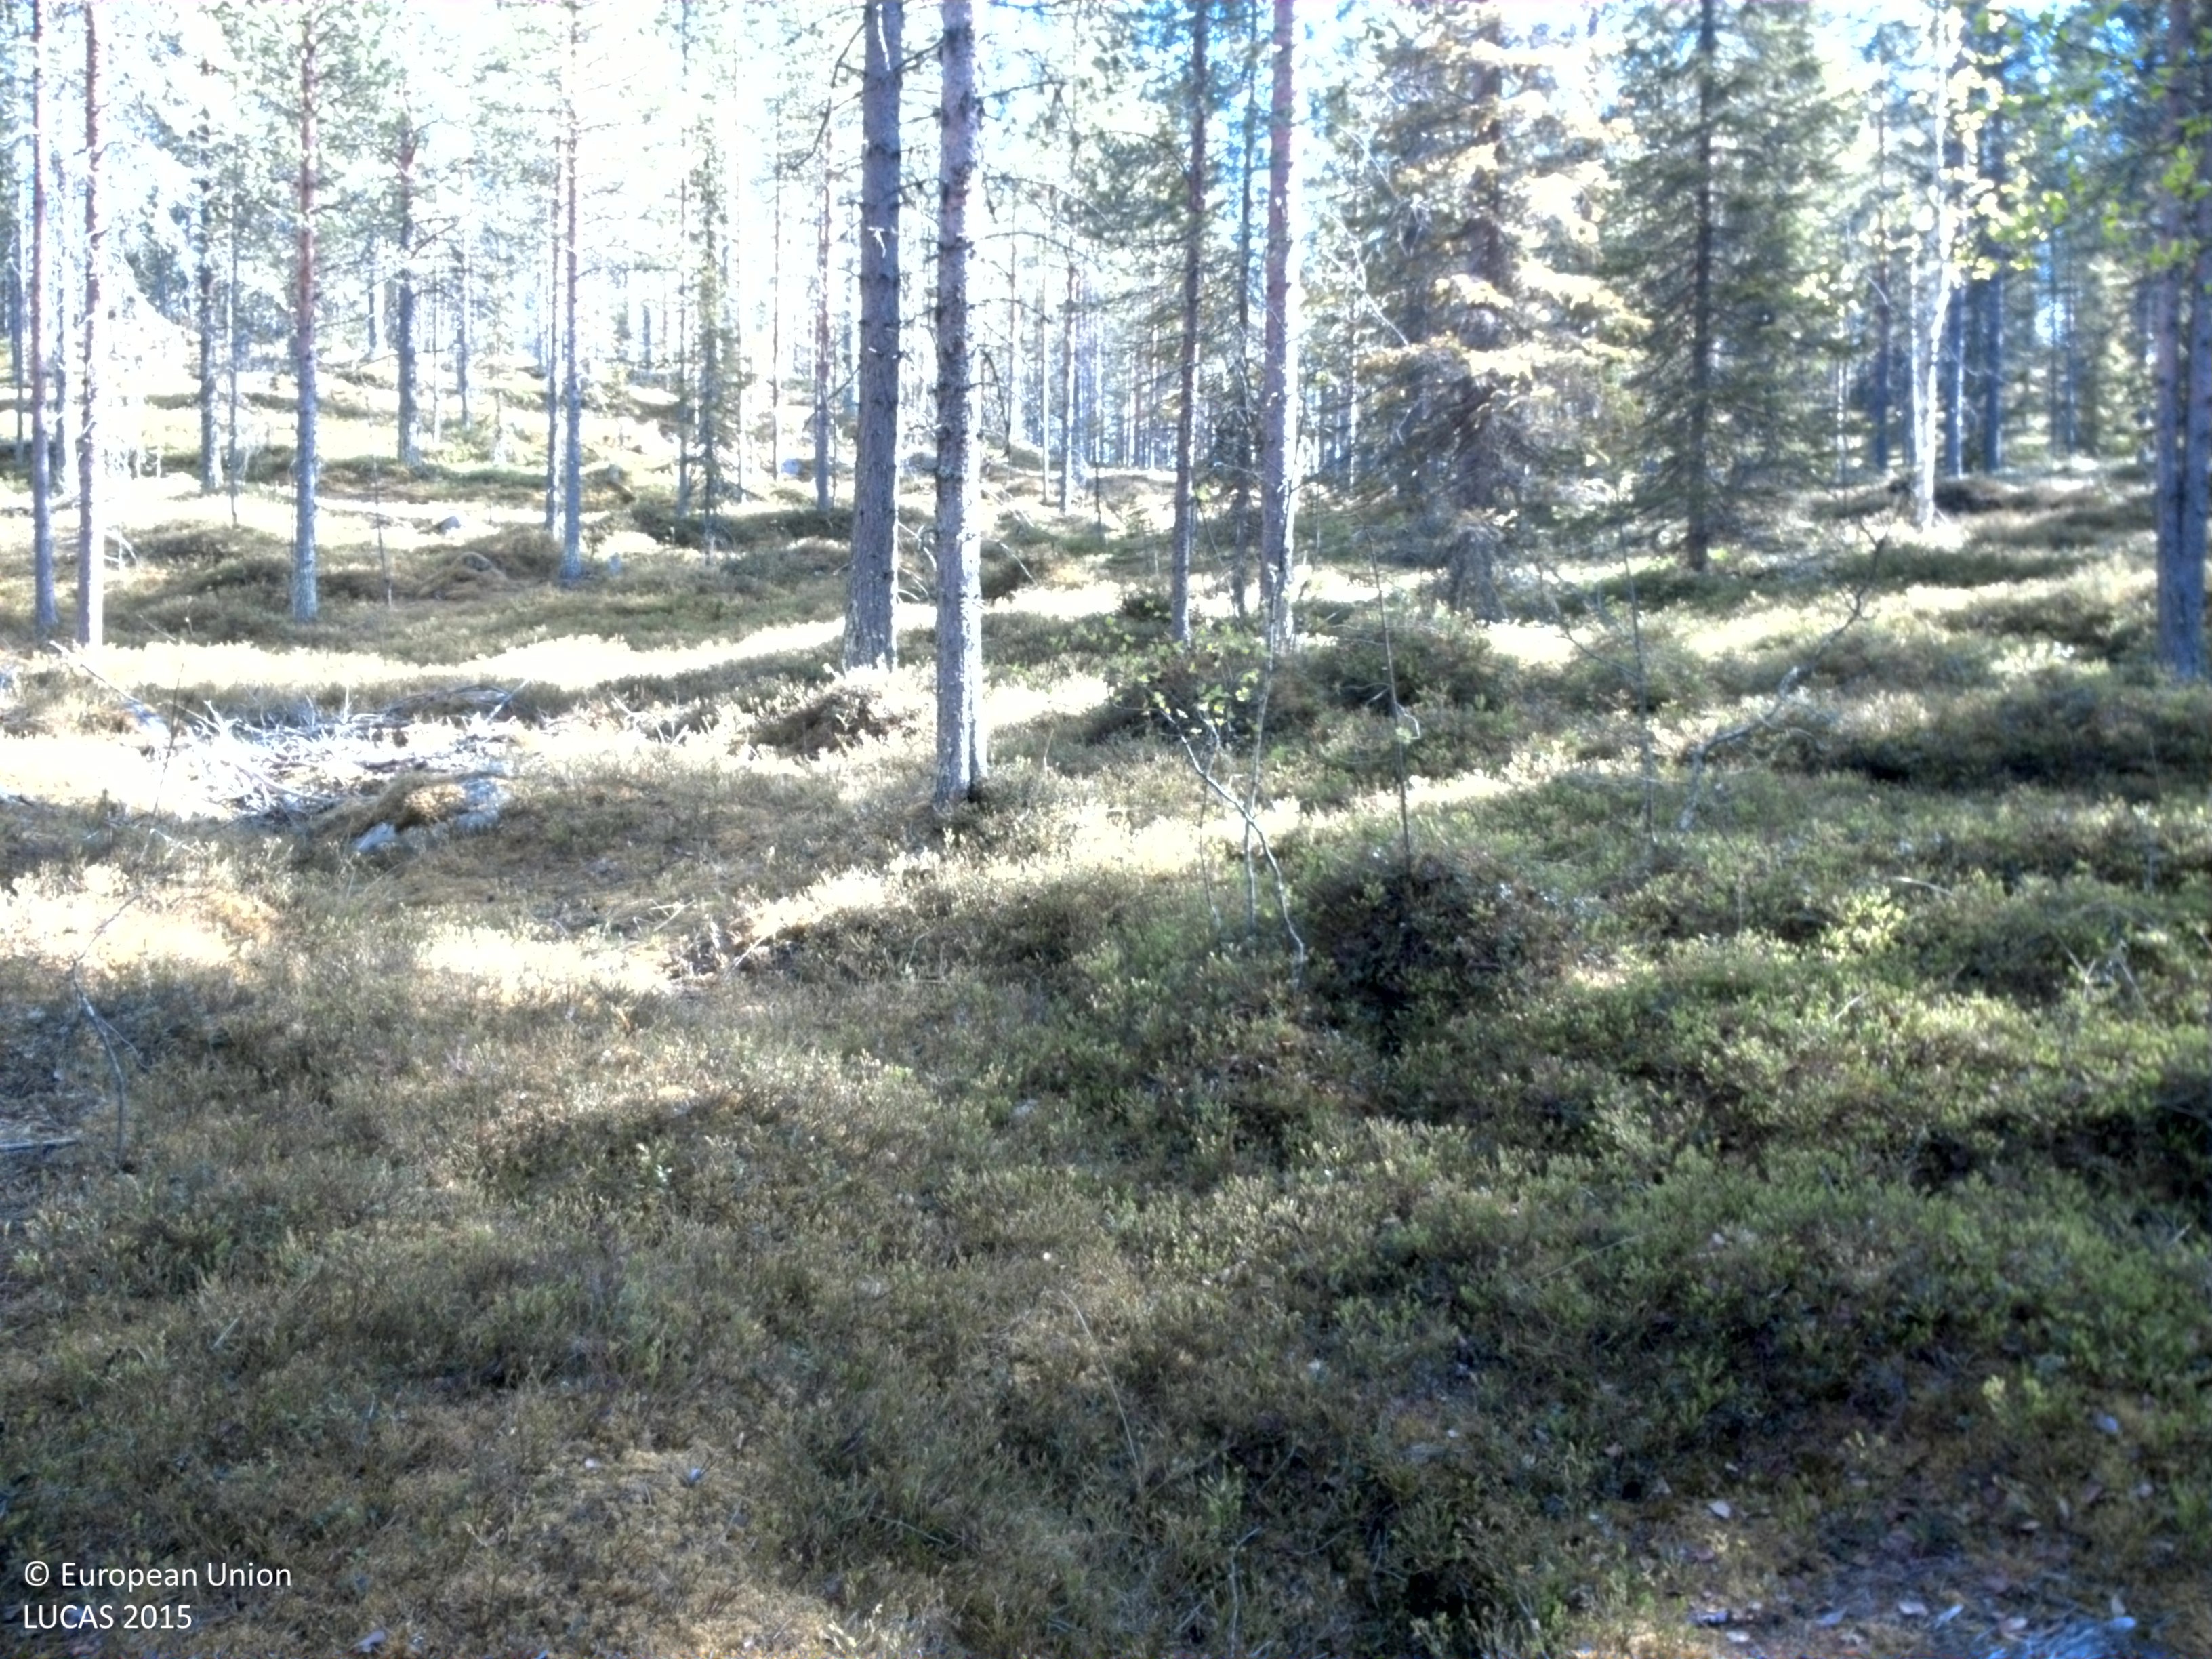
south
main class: Woodland
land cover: Pine dominated coniferous woodland
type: boreal forest
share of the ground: 25 - 50 %
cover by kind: herbaceous plants 65 %, coniferous forest trees 35 %
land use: Forestry
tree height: > 5 m
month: June
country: SE
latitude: 66.9420
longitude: 21.2811
